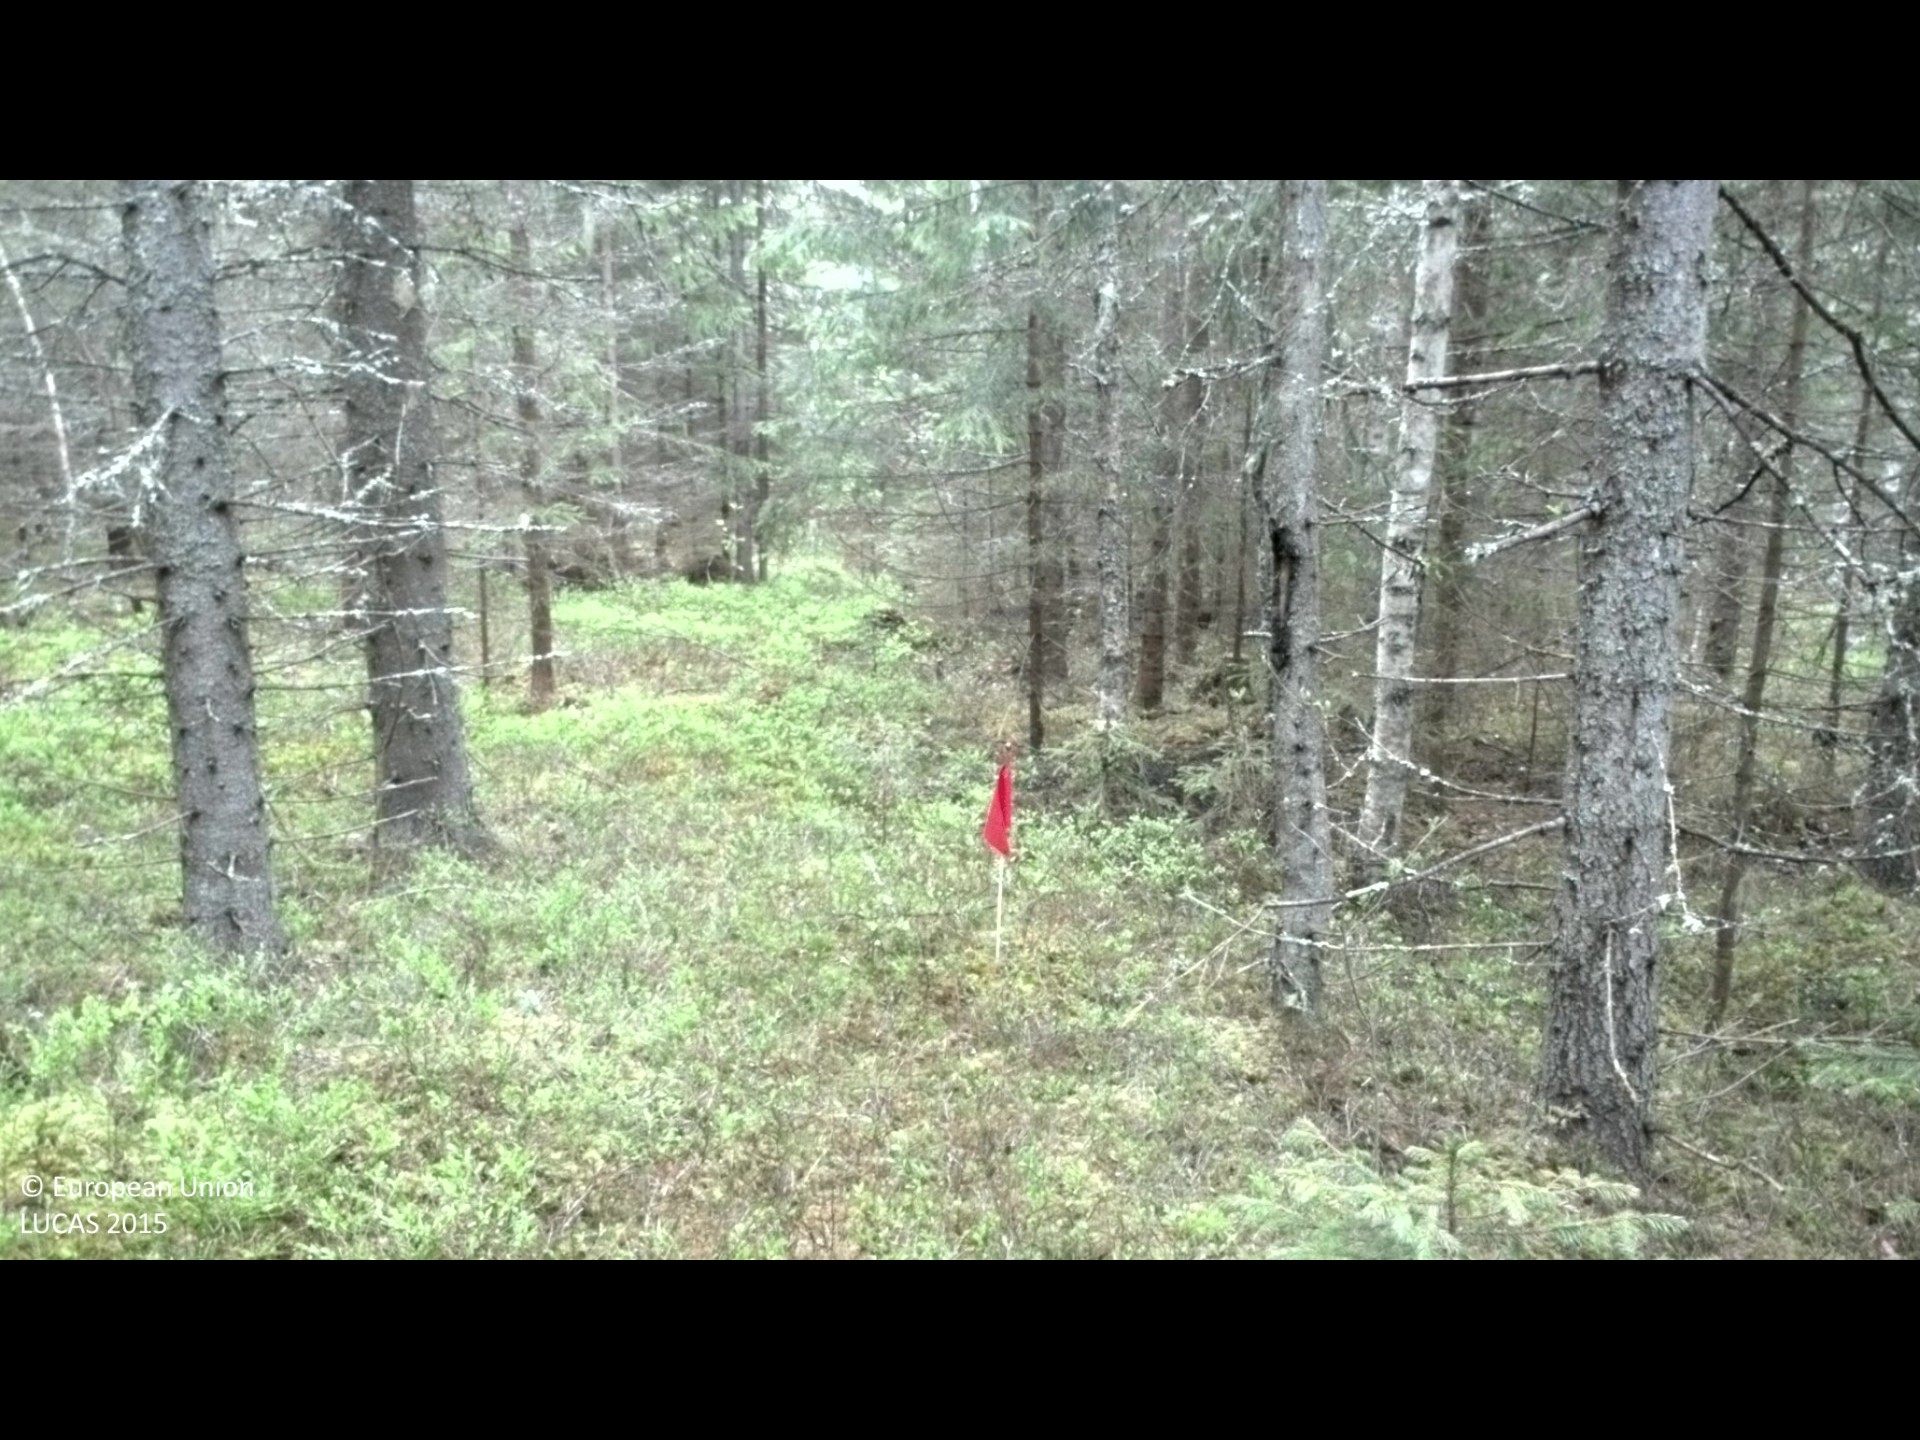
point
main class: Woodland
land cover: Spruce dominated mixed woodland
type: boreal forest
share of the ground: > 75 %
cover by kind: coniferous forest trees 60 %, broadleaved forest trees 20 %, shrubs 20 %
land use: Forestry
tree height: > 5 m
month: May
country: SE
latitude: 62.9777
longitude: 17.6915
